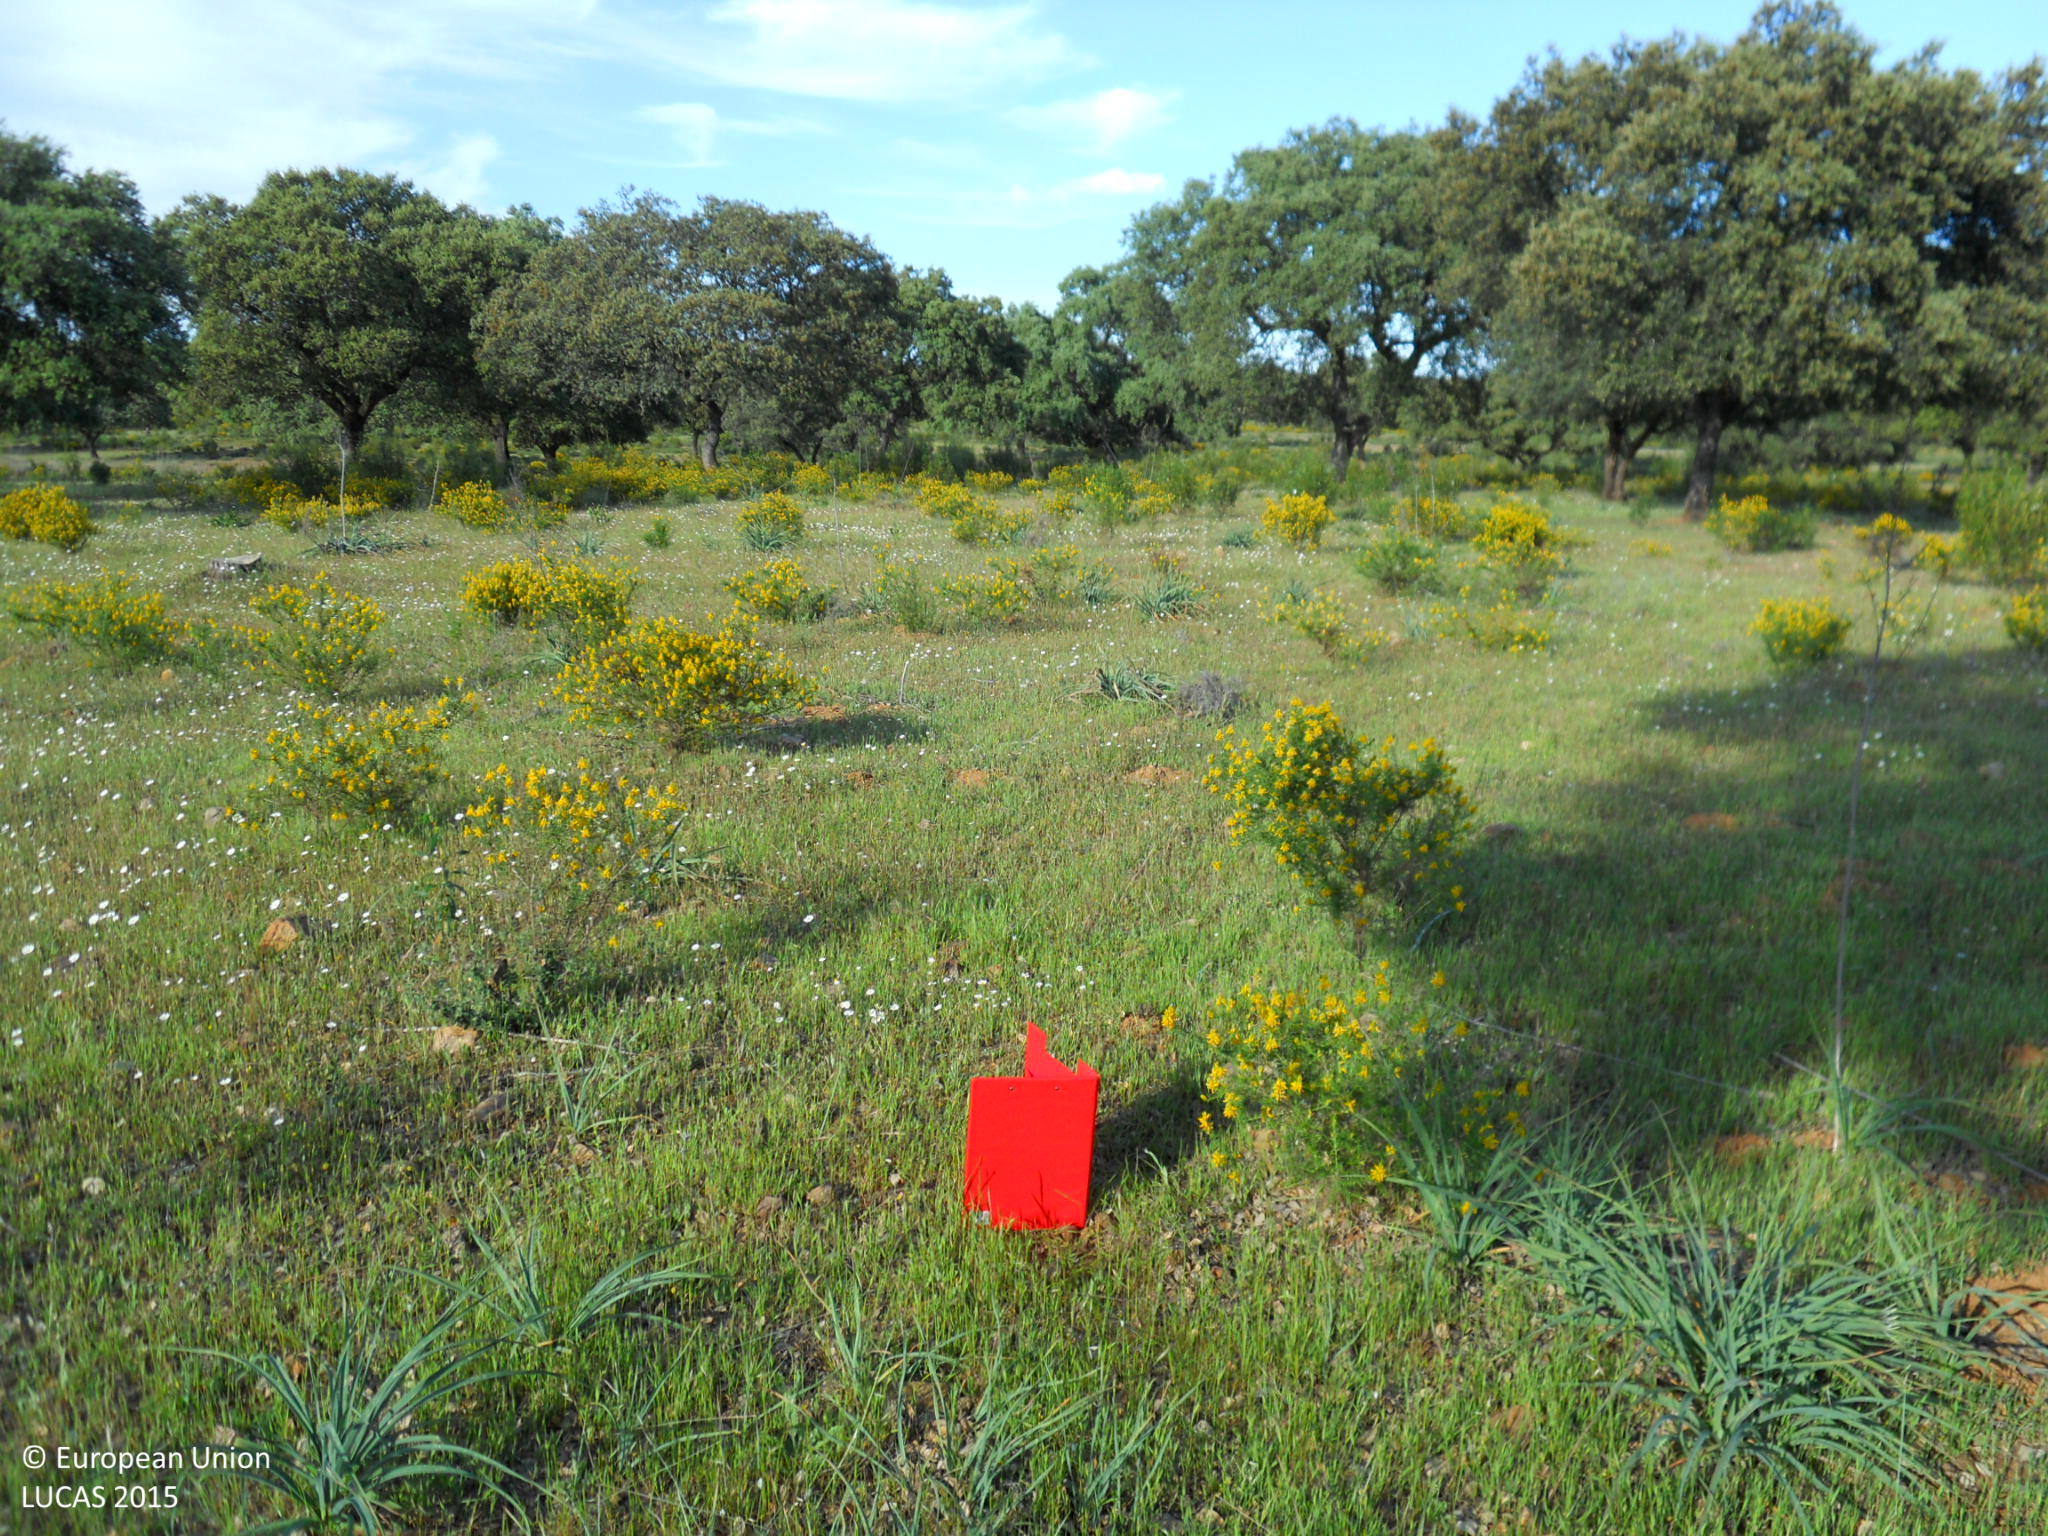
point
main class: Woodland
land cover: Broadleaved woodland
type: broadleaved evergreen forest
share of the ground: 50 - 75 %
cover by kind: broadleaved forest trees 70 %, herbaceous plants 20 %, shrubs 10 %
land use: Forestry
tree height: > 5 m
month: April
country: ES
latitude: 39.3562
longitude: -6.8214
